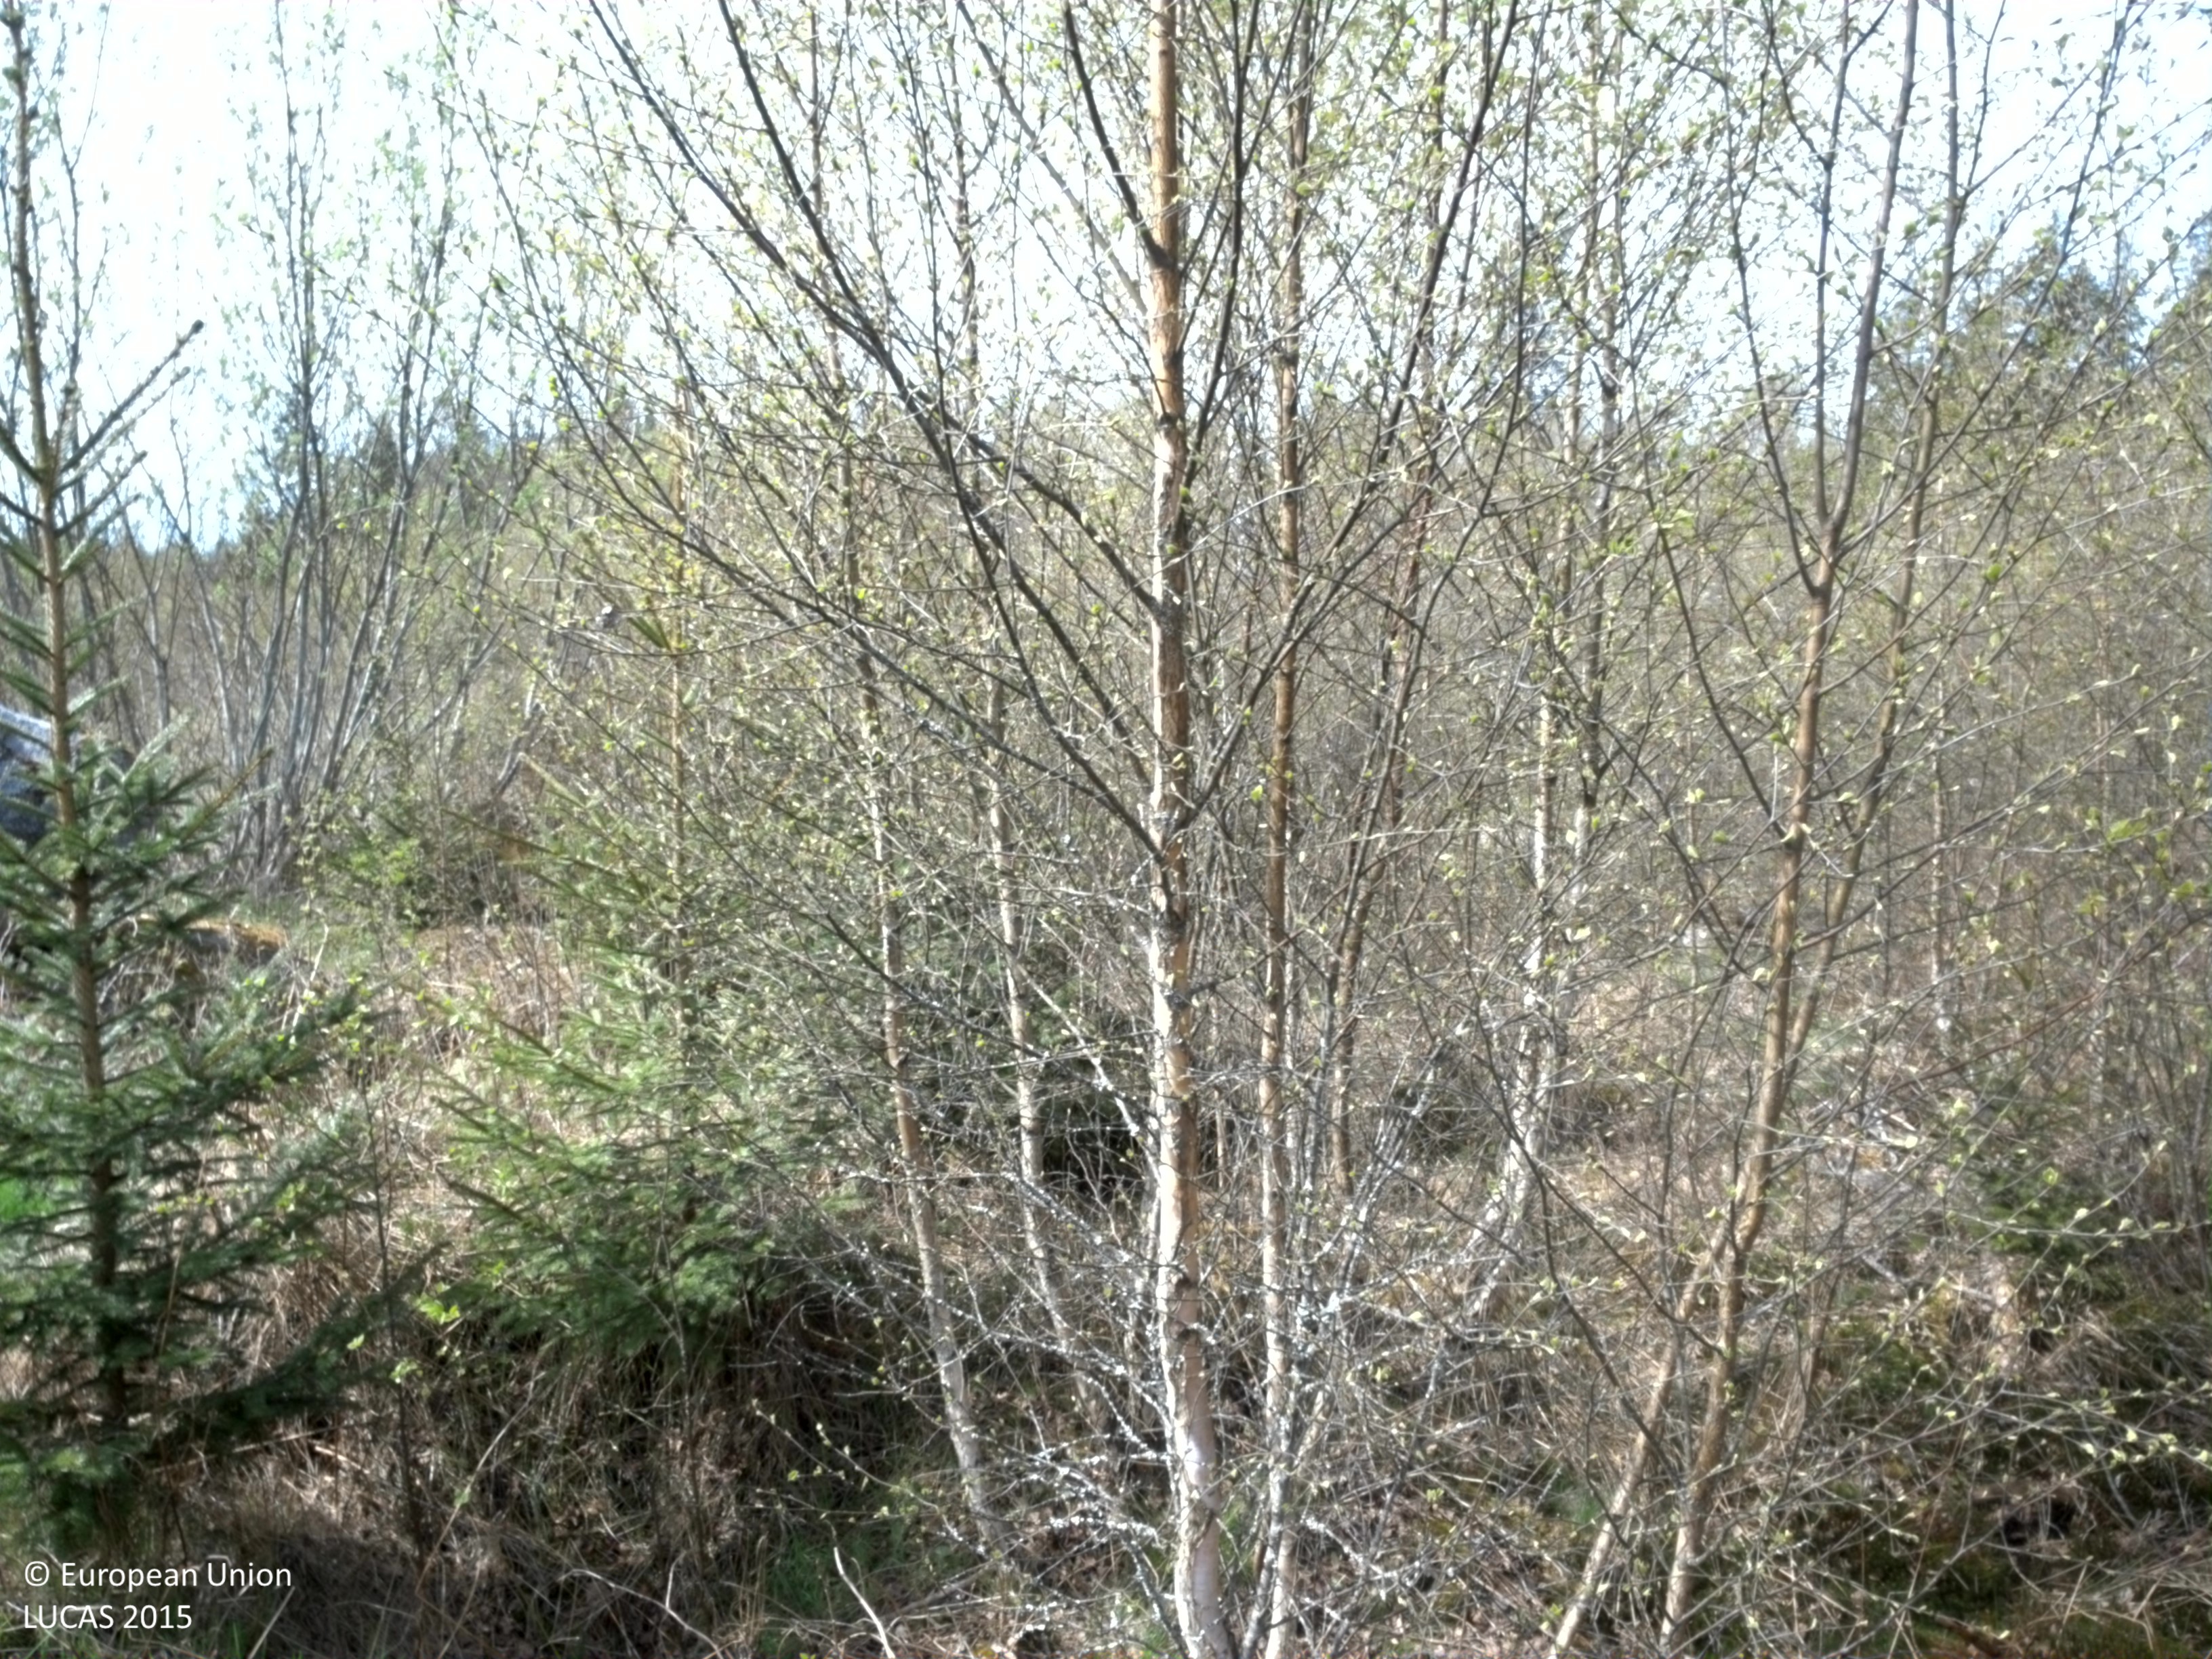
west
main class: Woodland
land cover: Broadleaved woodland
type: boreal forest
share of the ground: > 75 %
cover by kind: broadleaved forest trees 75 %, coniferous forest trees 15 %, shrubs 5 %, herbaceous plants 5 %
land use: Forestry
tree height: < 5 m
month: May
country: SE
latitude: 56.7995
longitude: 14.8278
